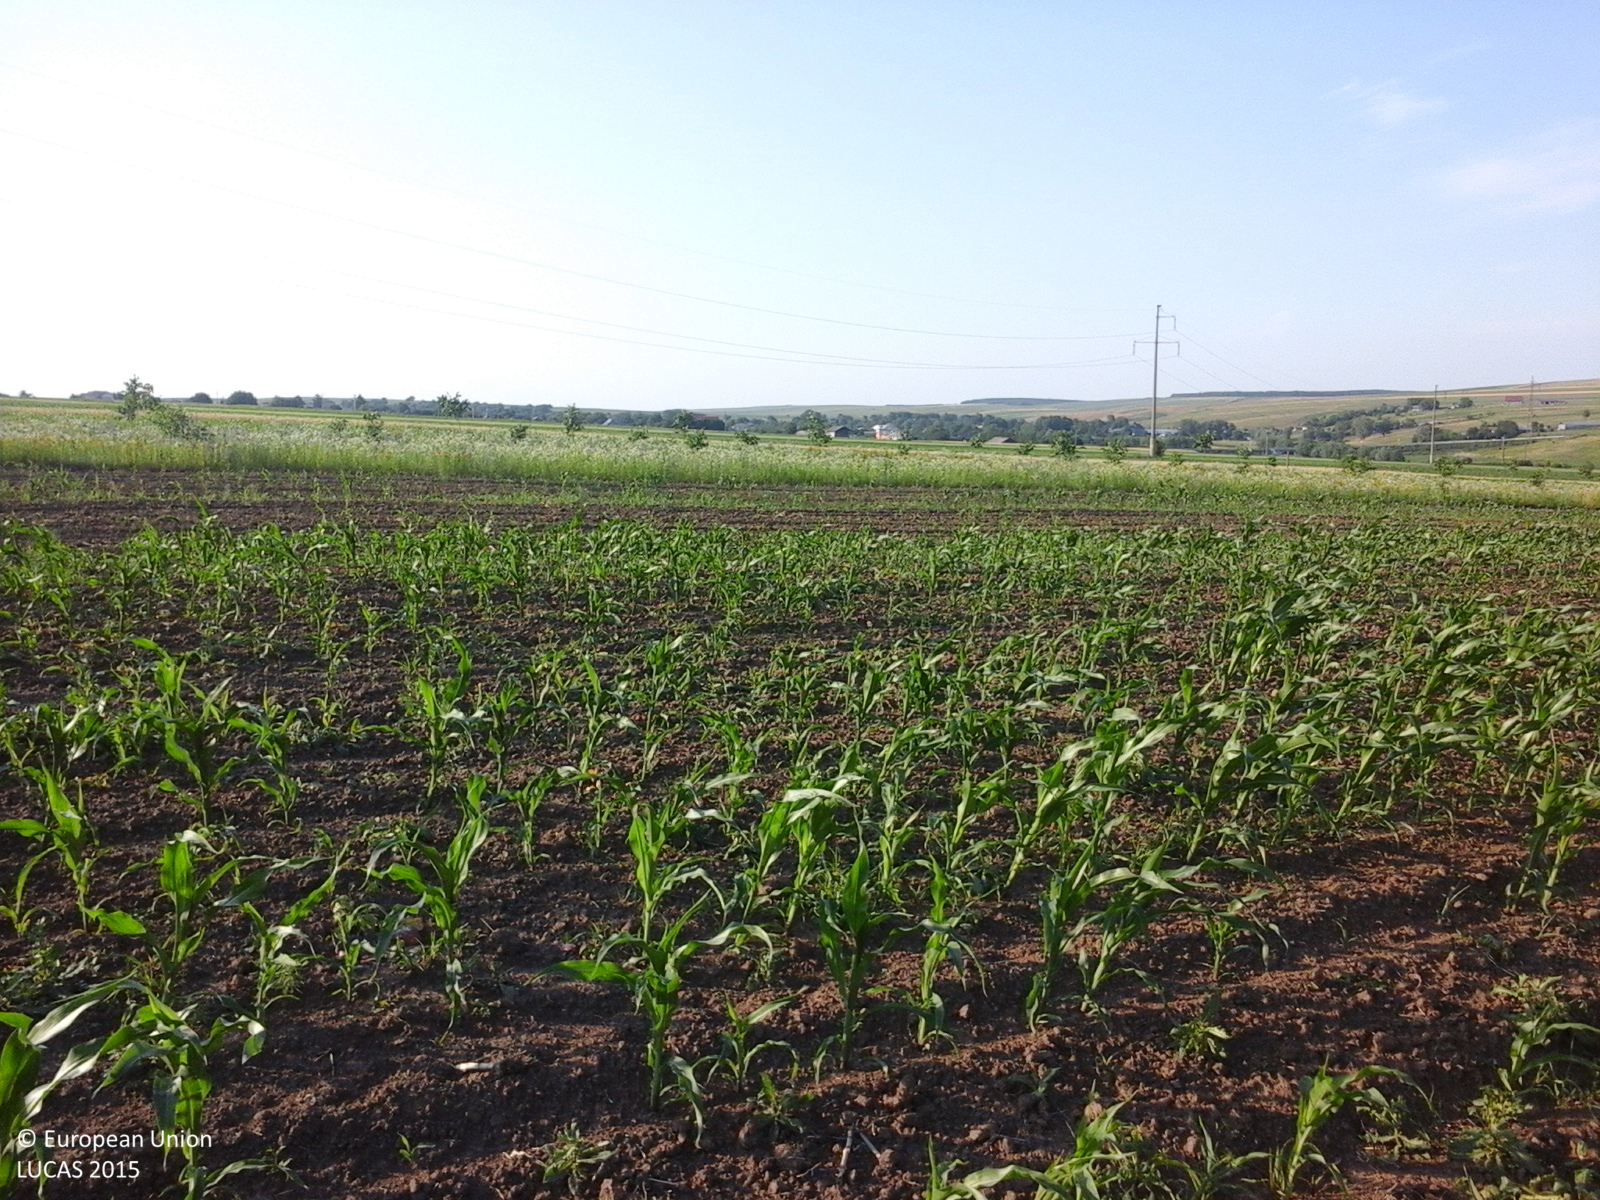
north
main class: Cropland
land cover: Maize
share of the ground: 25 - 50 %
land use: Agriculture (excluding fallow land and kitchen gardens)
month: June
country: RO
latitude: 47.7080
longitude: 26.4692
